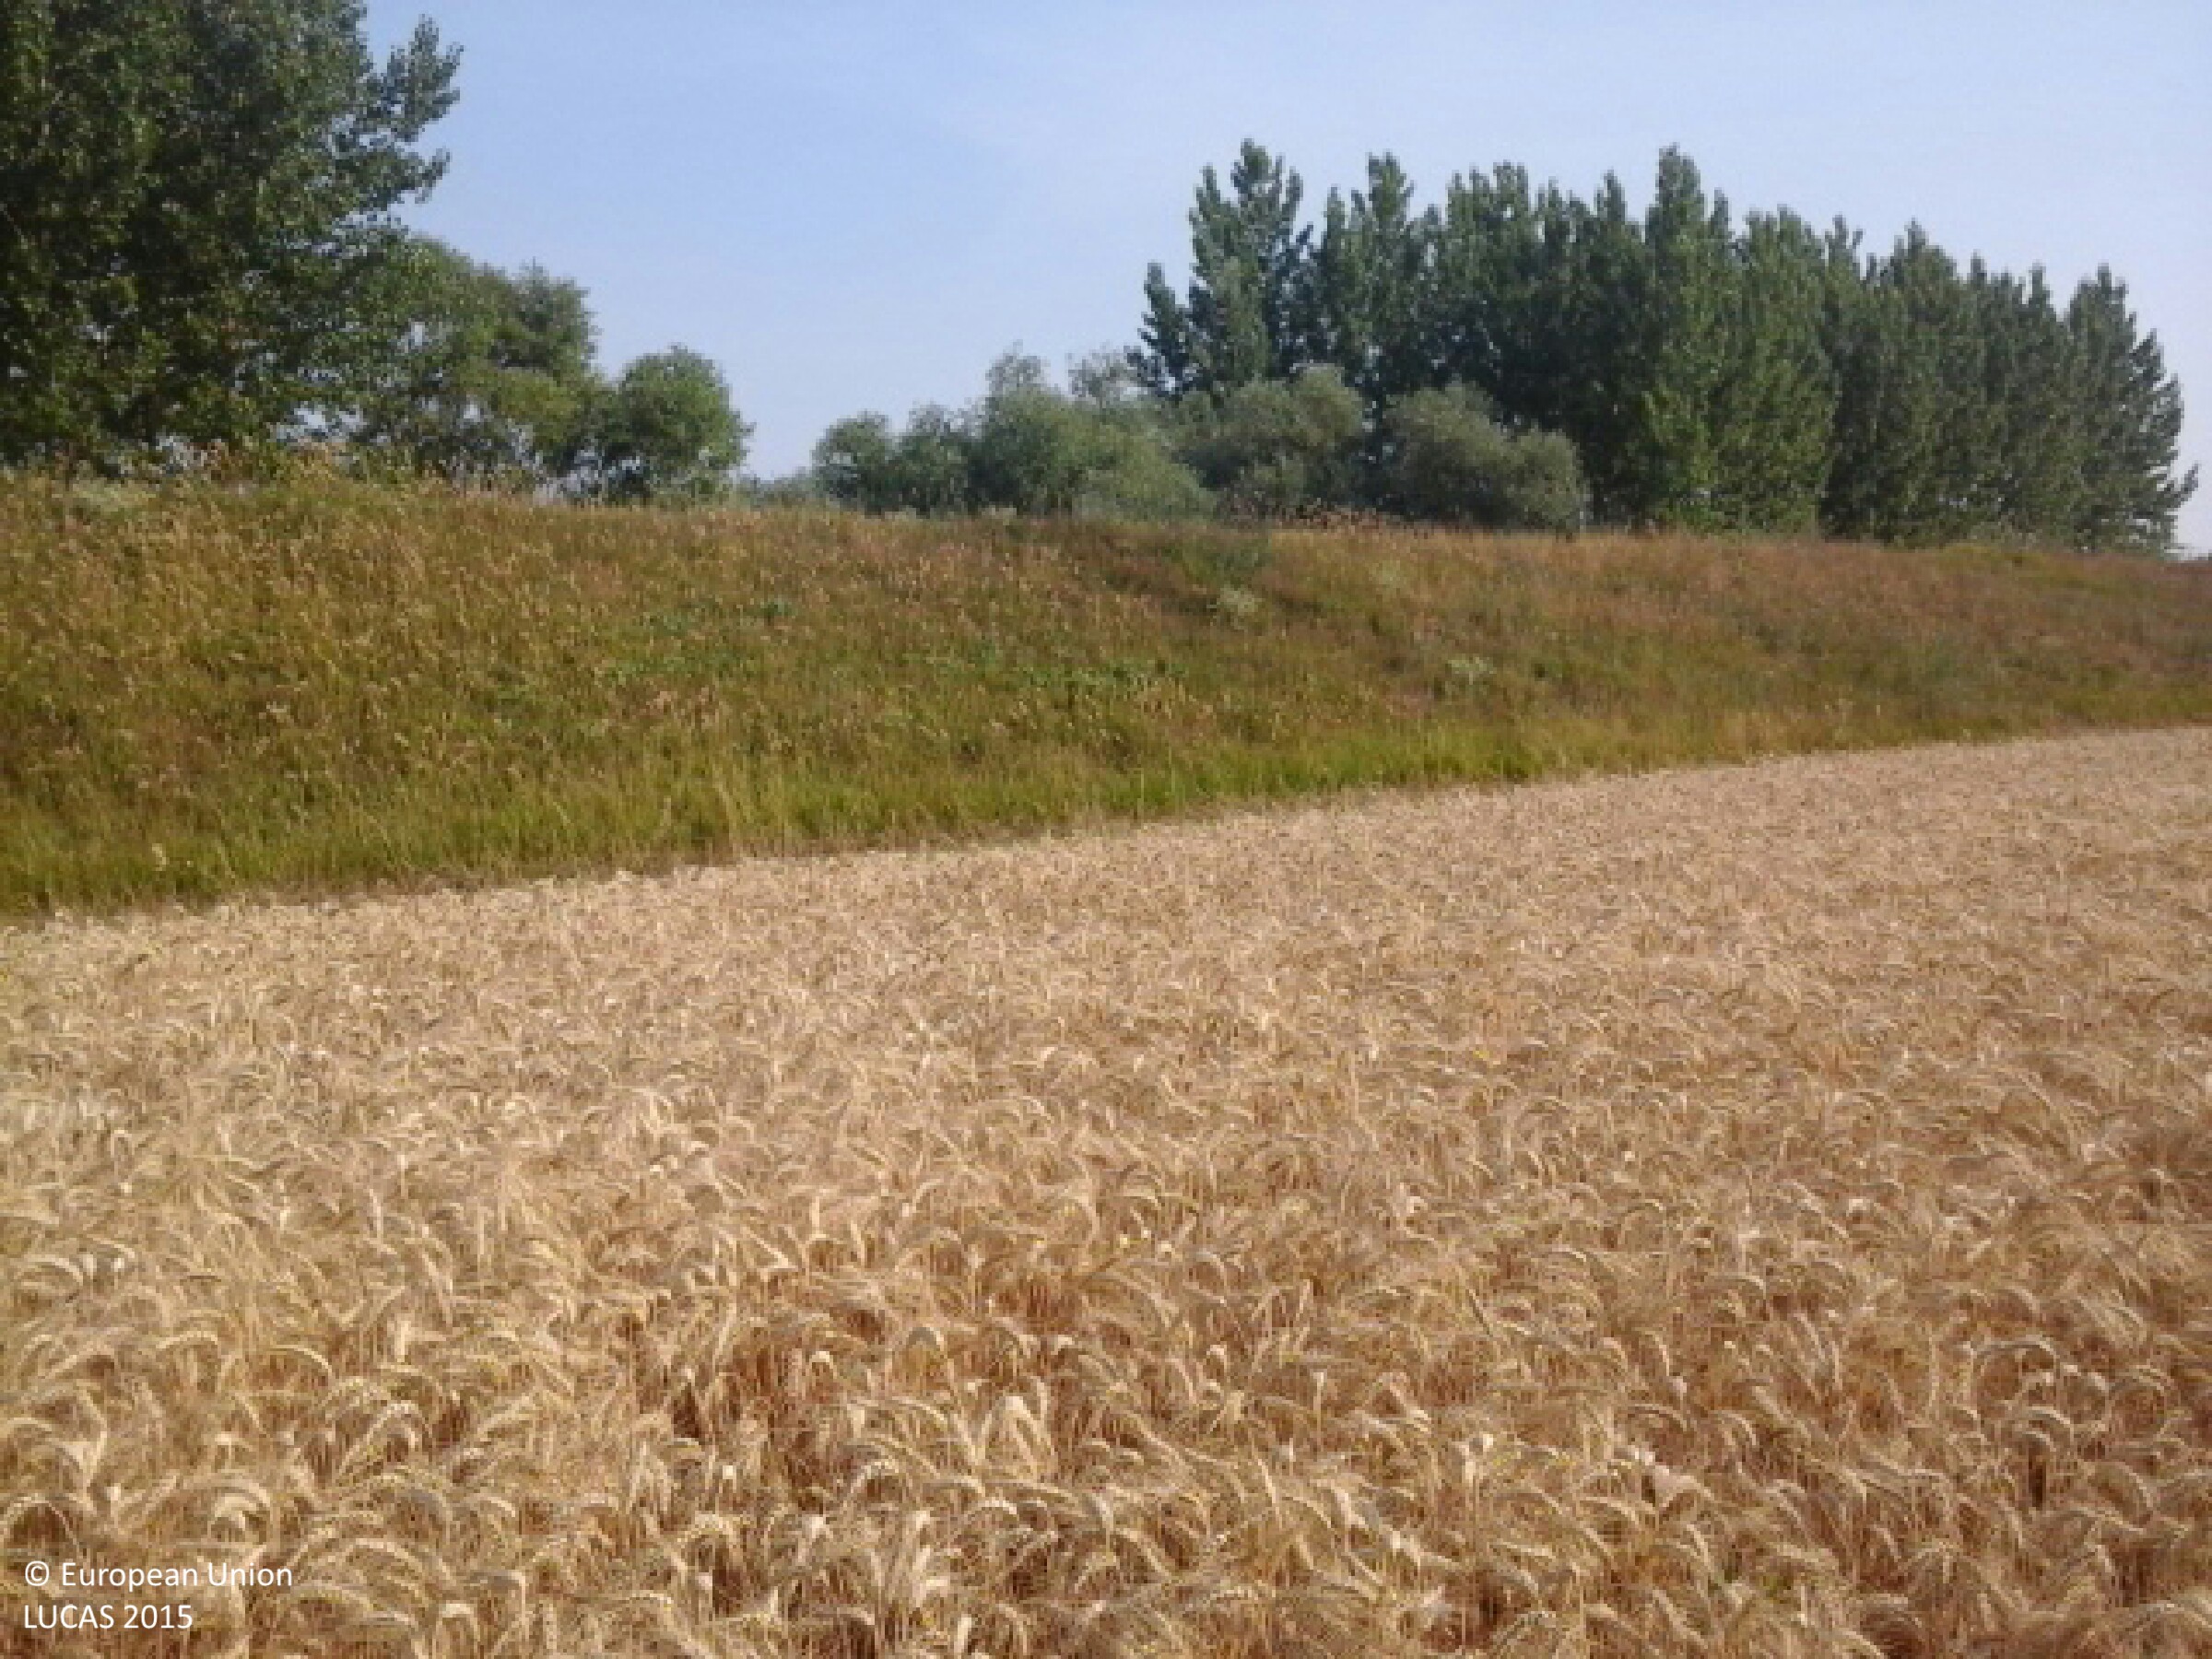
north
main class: Cropland
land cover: Barley
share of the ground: > 75 %
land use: Agriculture (excluding fallow land and kitchen gardens)
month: July
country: HU
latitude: 48.0596
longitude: 21.1103
